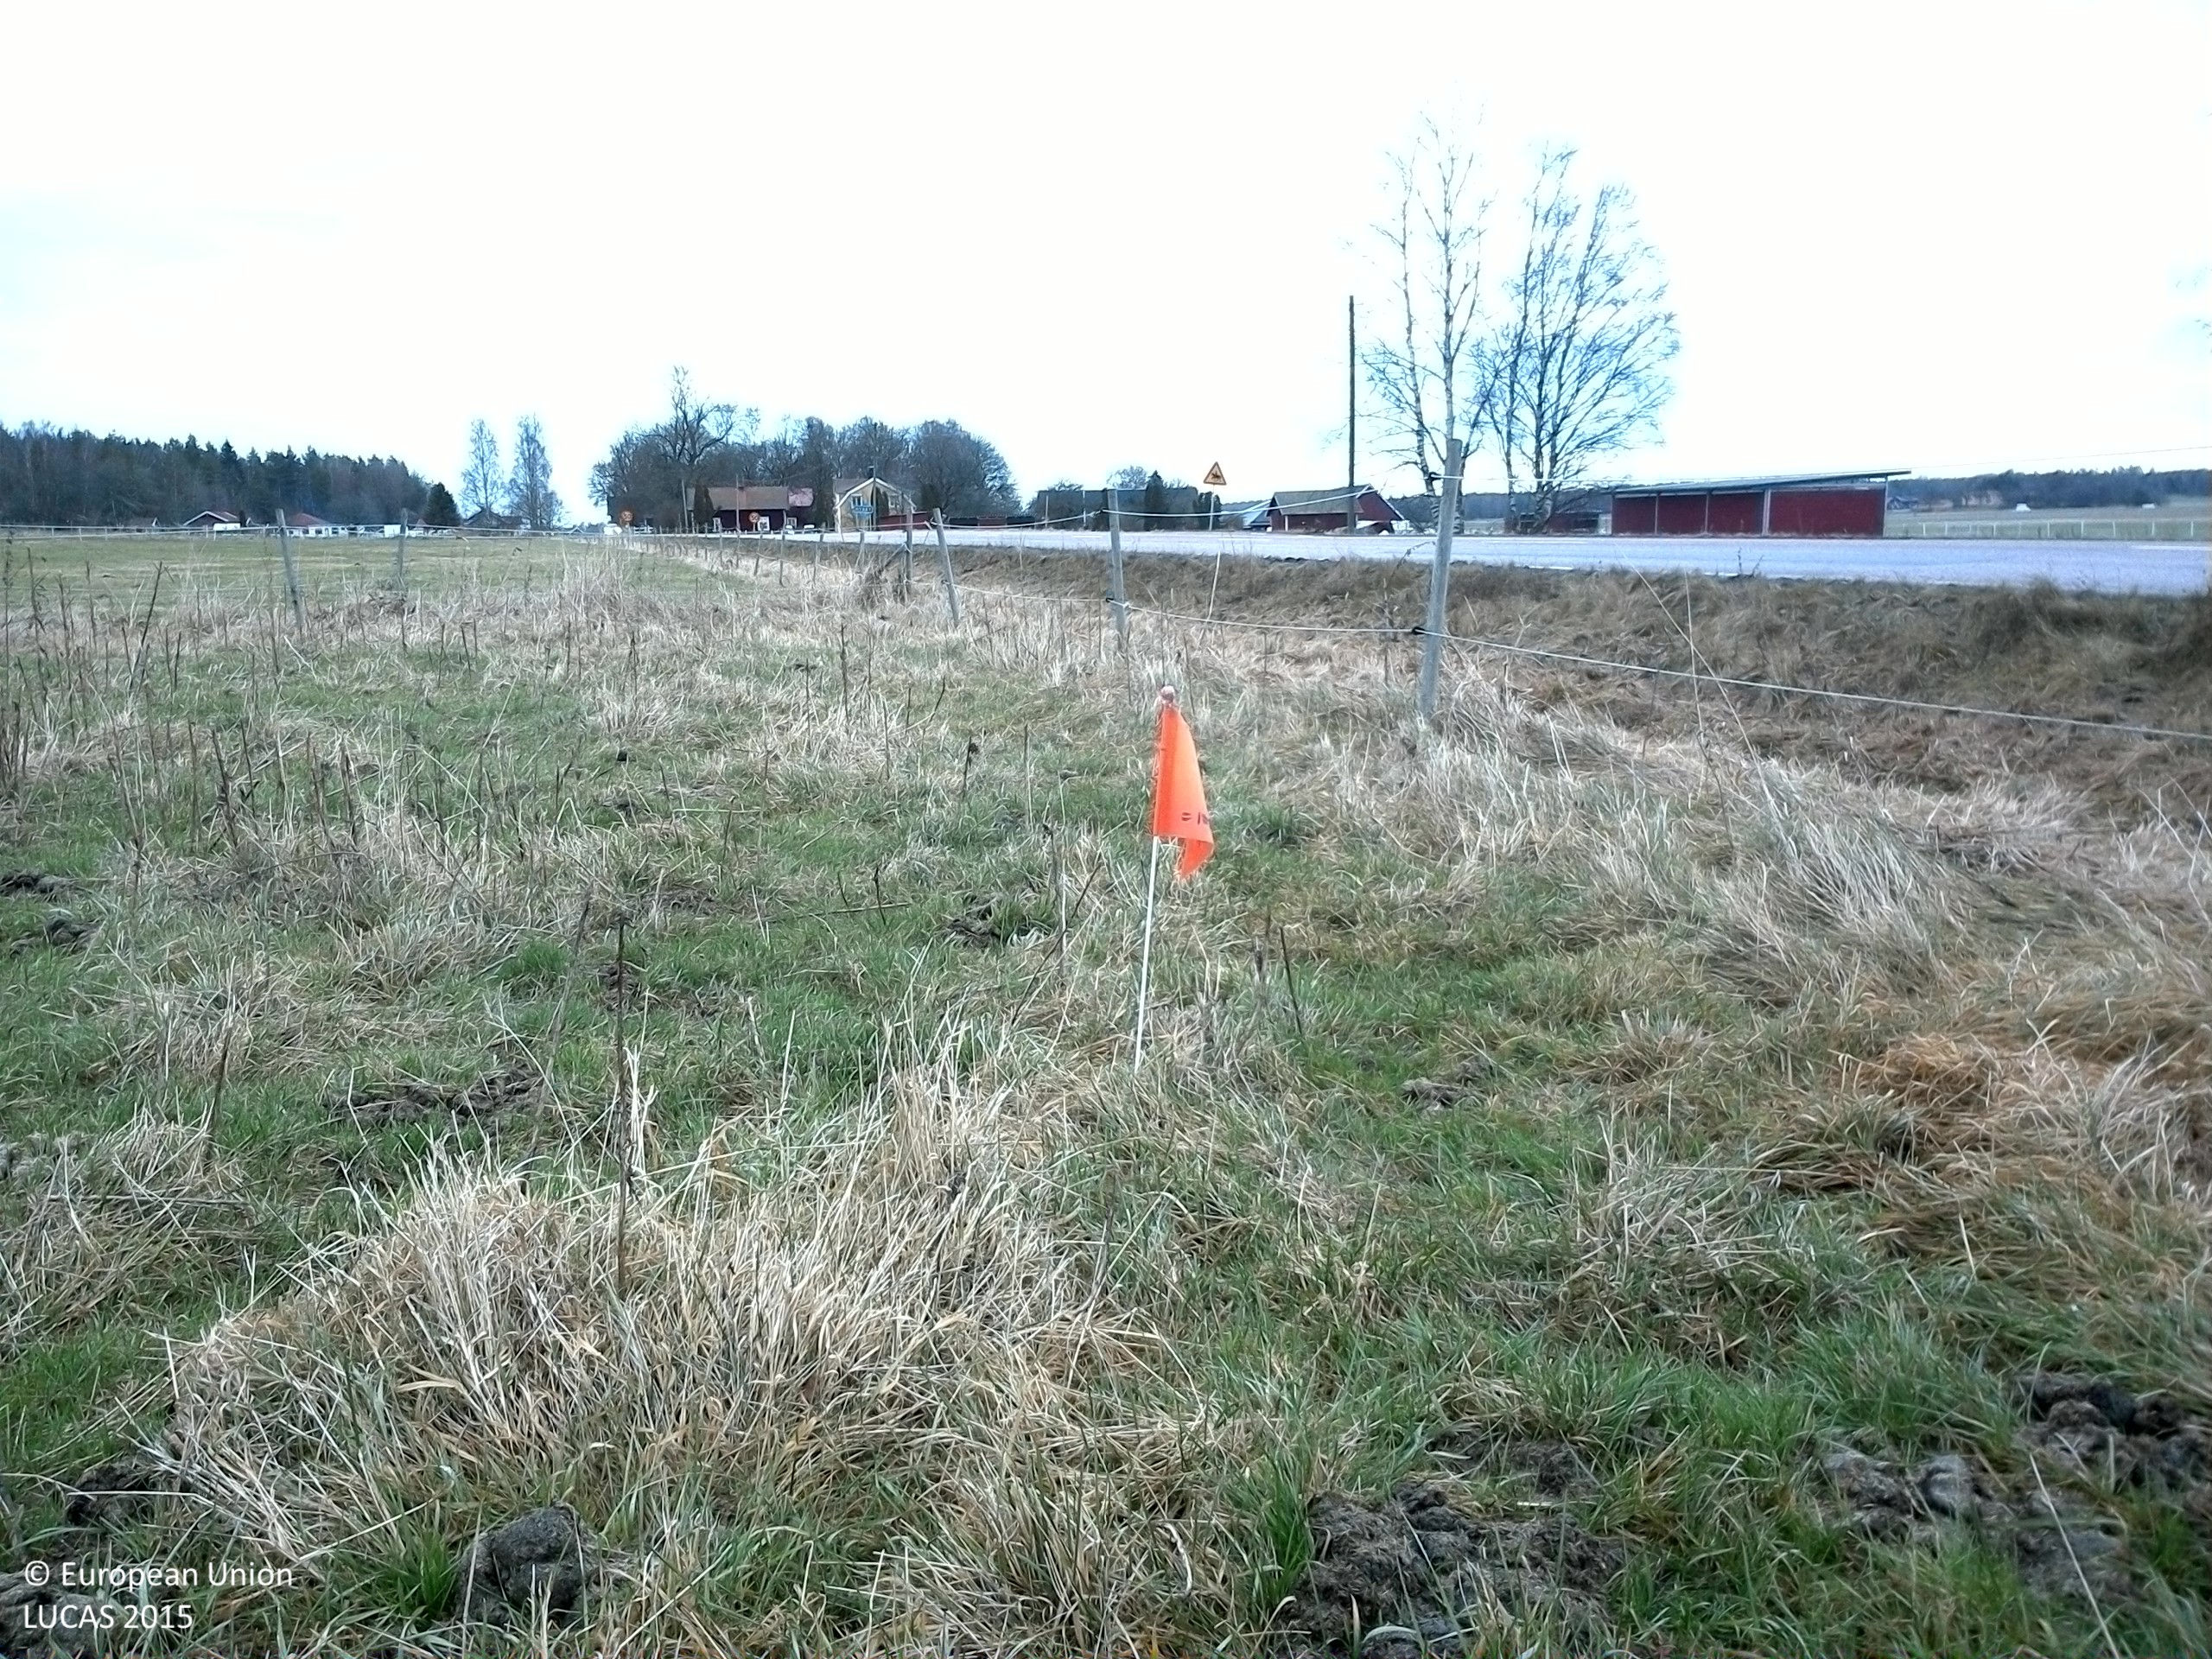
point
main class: Grassland
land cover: Grassland without tree/shrub cover
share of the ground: > 75 %
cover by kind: herbaceous plants 100 %
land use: Agriculture (excluding fallow land and kitchen gardens)
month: December
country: SE
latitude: 59.6429
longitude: 16.6801
